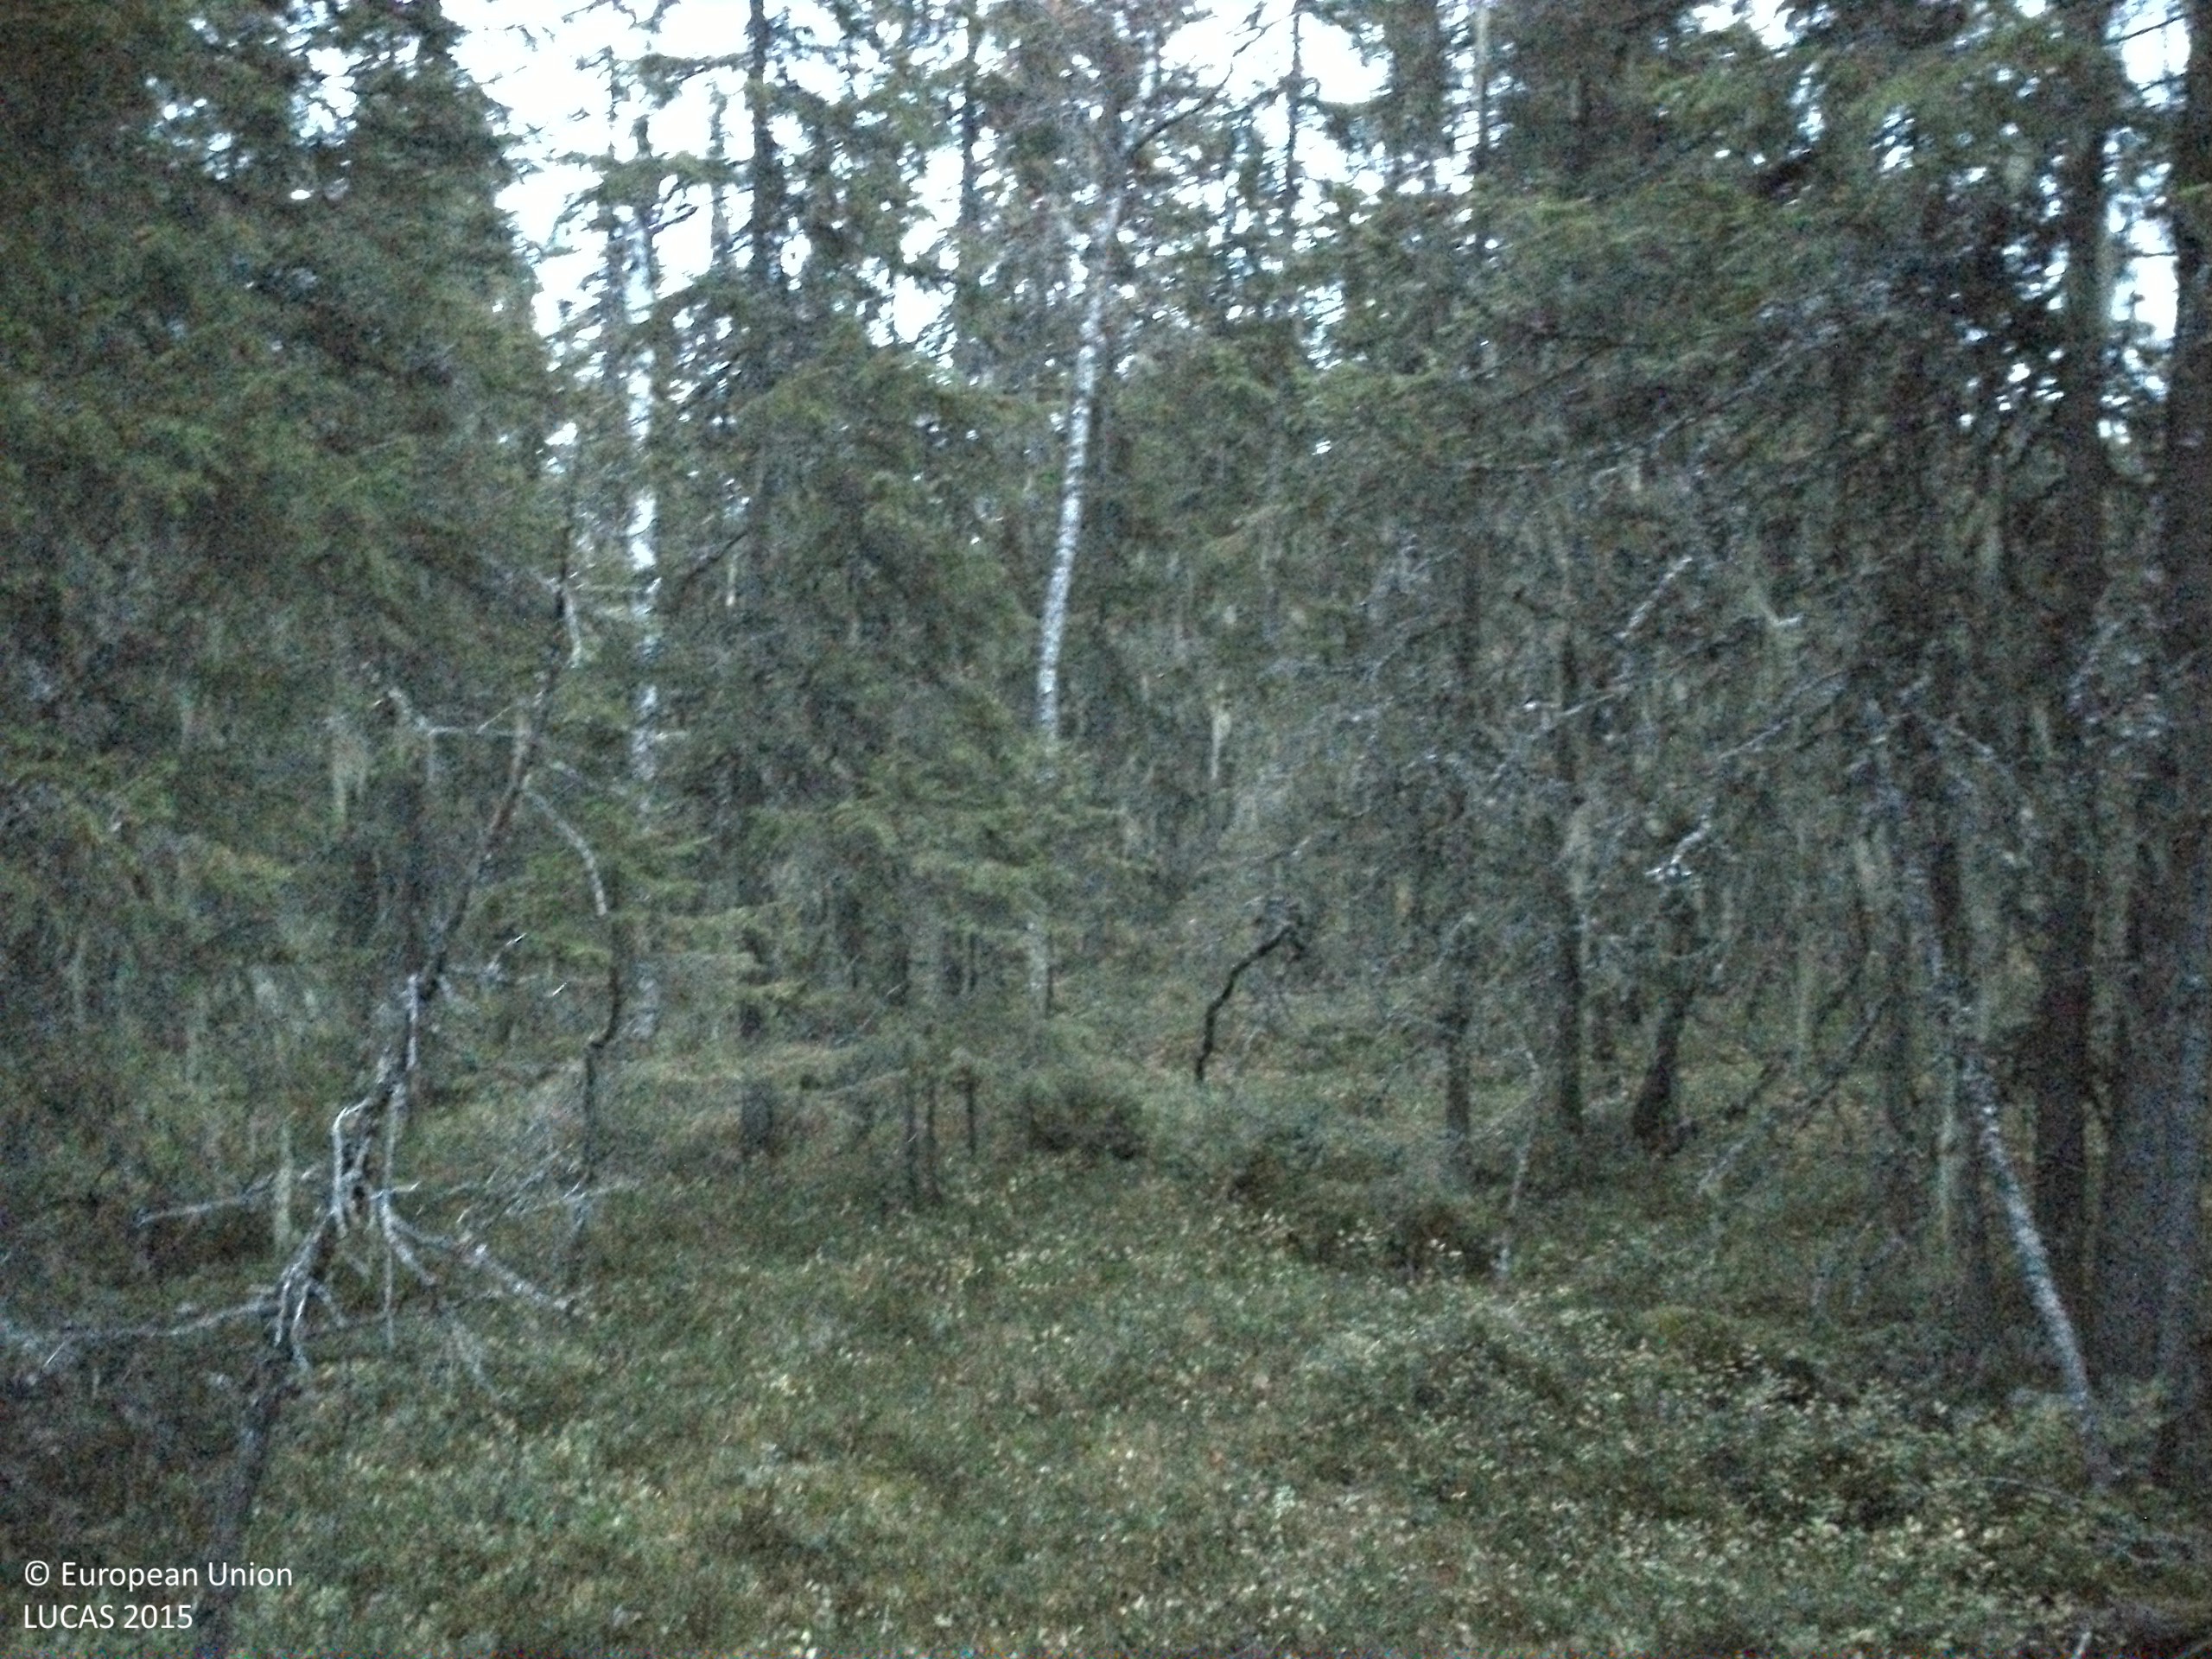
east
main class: Woodland
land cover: Spruce dominated coniferous woodland
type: boreal forest
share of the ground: 50 - 75 %
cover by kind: coniferous forest trees 65 %, shrubs 30 %, broadleaved forest trees 5 %
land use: Forestry
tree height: > 5 m
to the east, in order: Spruce dominated coniferous woodland; Pine dominated mixed woodland; Other coniferous woodland; Spruce dominated mixed woodland; Spruce dominated coniferous woodland; Spruce dominated mixed woodland
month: October
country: SE
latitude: 61.3943
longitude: 14.3482
